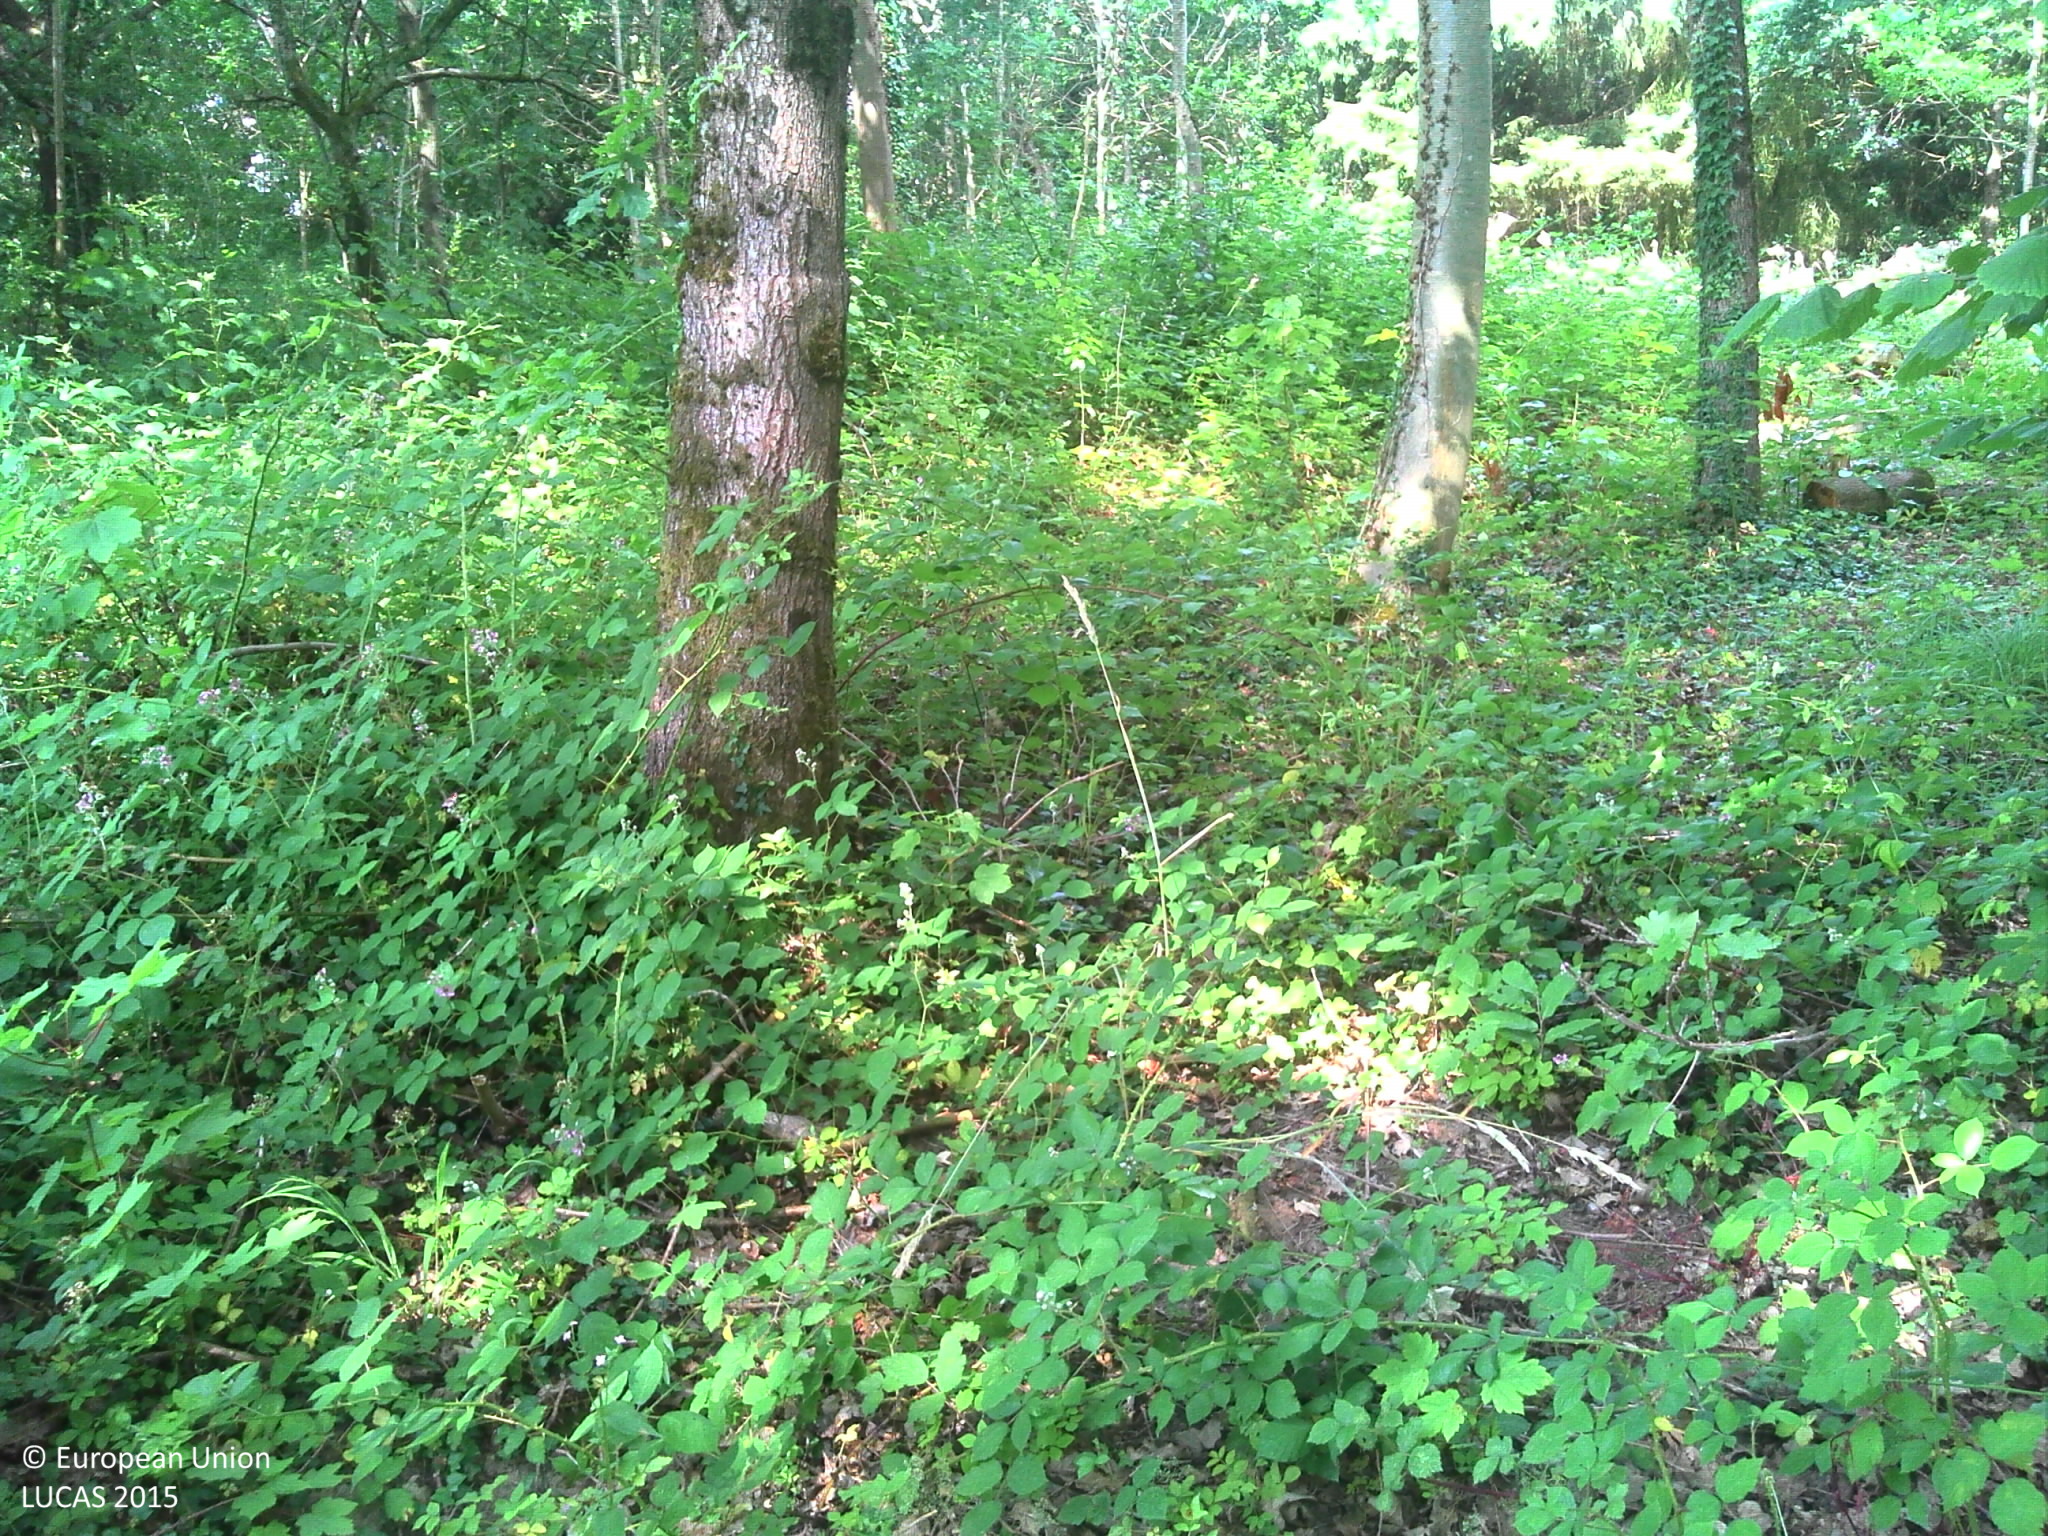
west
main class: Woodland
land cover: Broadleaved woodland
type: mesophytic deciduous forest
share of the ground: > 75 %
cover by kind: broadleaved forest trees 80 %, shrubs 10 %, herbaceous plants 10 %
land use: Forestry
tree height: > 5 m
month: July
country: FR
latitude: 49.1057
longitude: 3.3490
